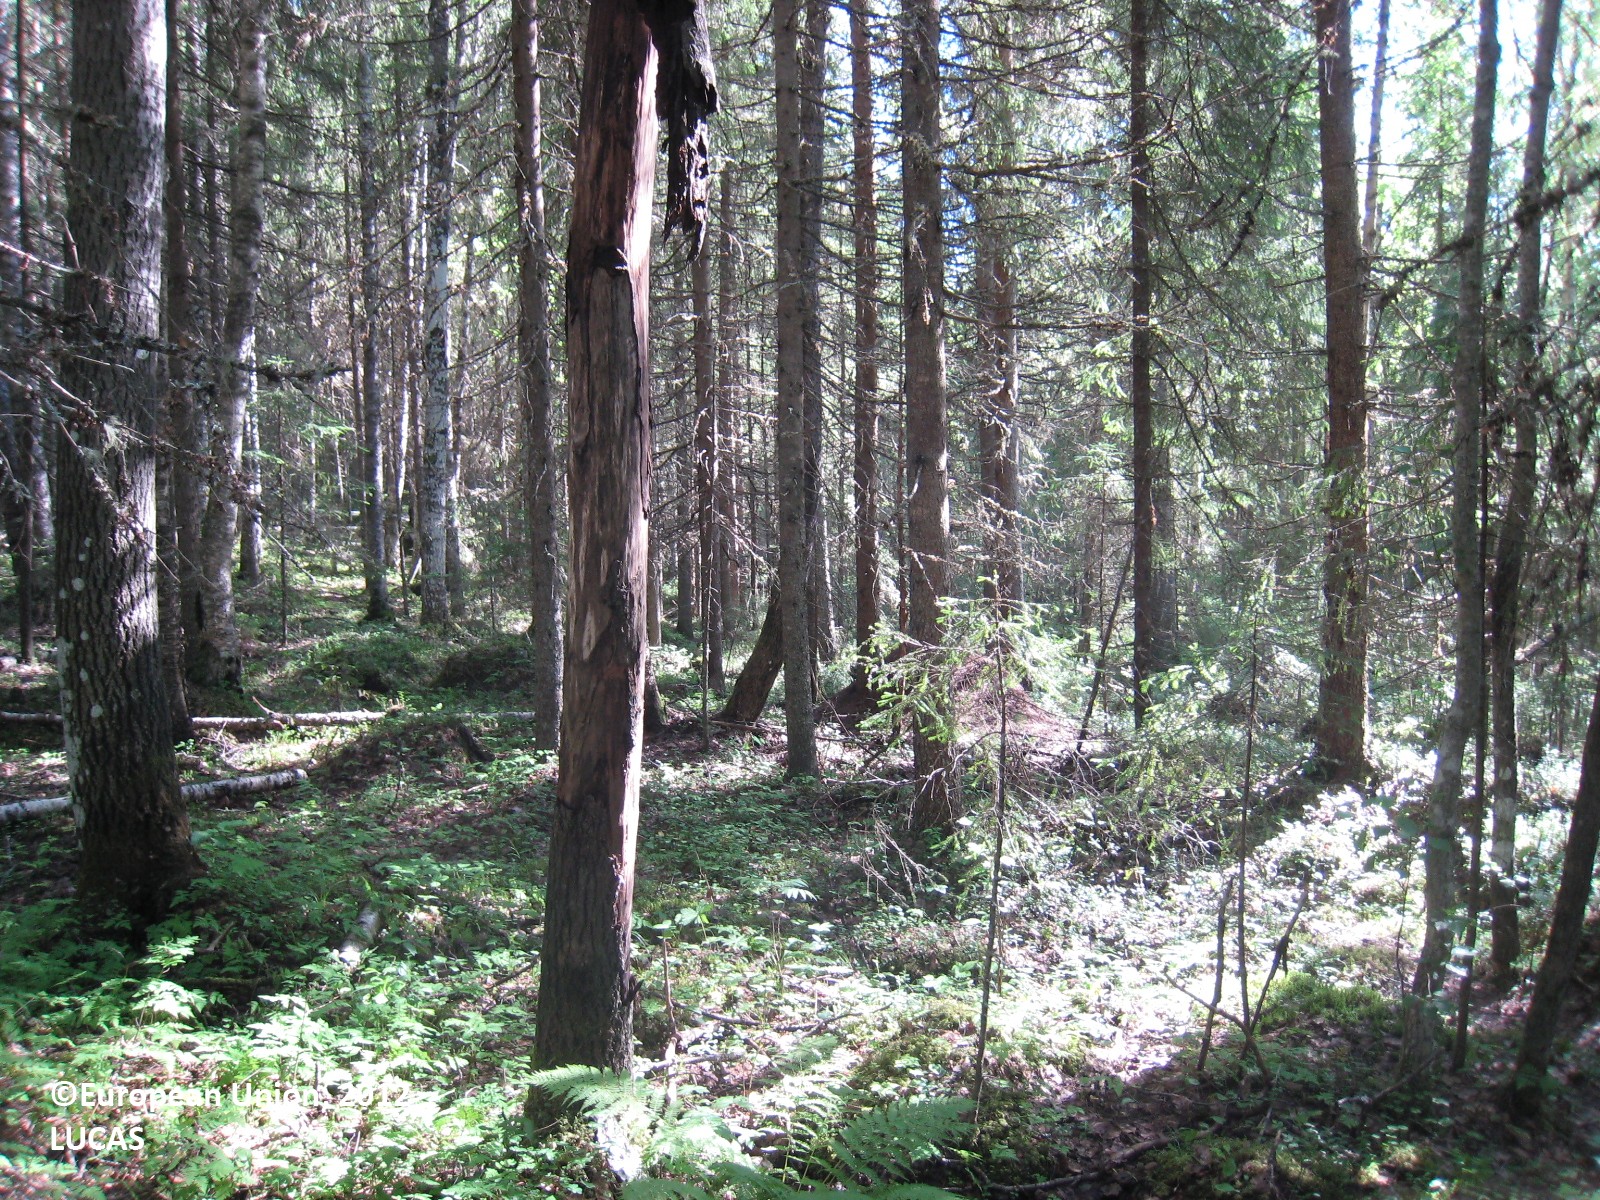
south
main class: Woodland
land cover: Spruce dominated mixed woodland
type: boreal forest
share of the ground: > 75 %
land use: Semi-natural and natural areas not in use
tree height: > 5 m
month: July
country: FI
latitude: 63.1938
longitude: 26.8144
